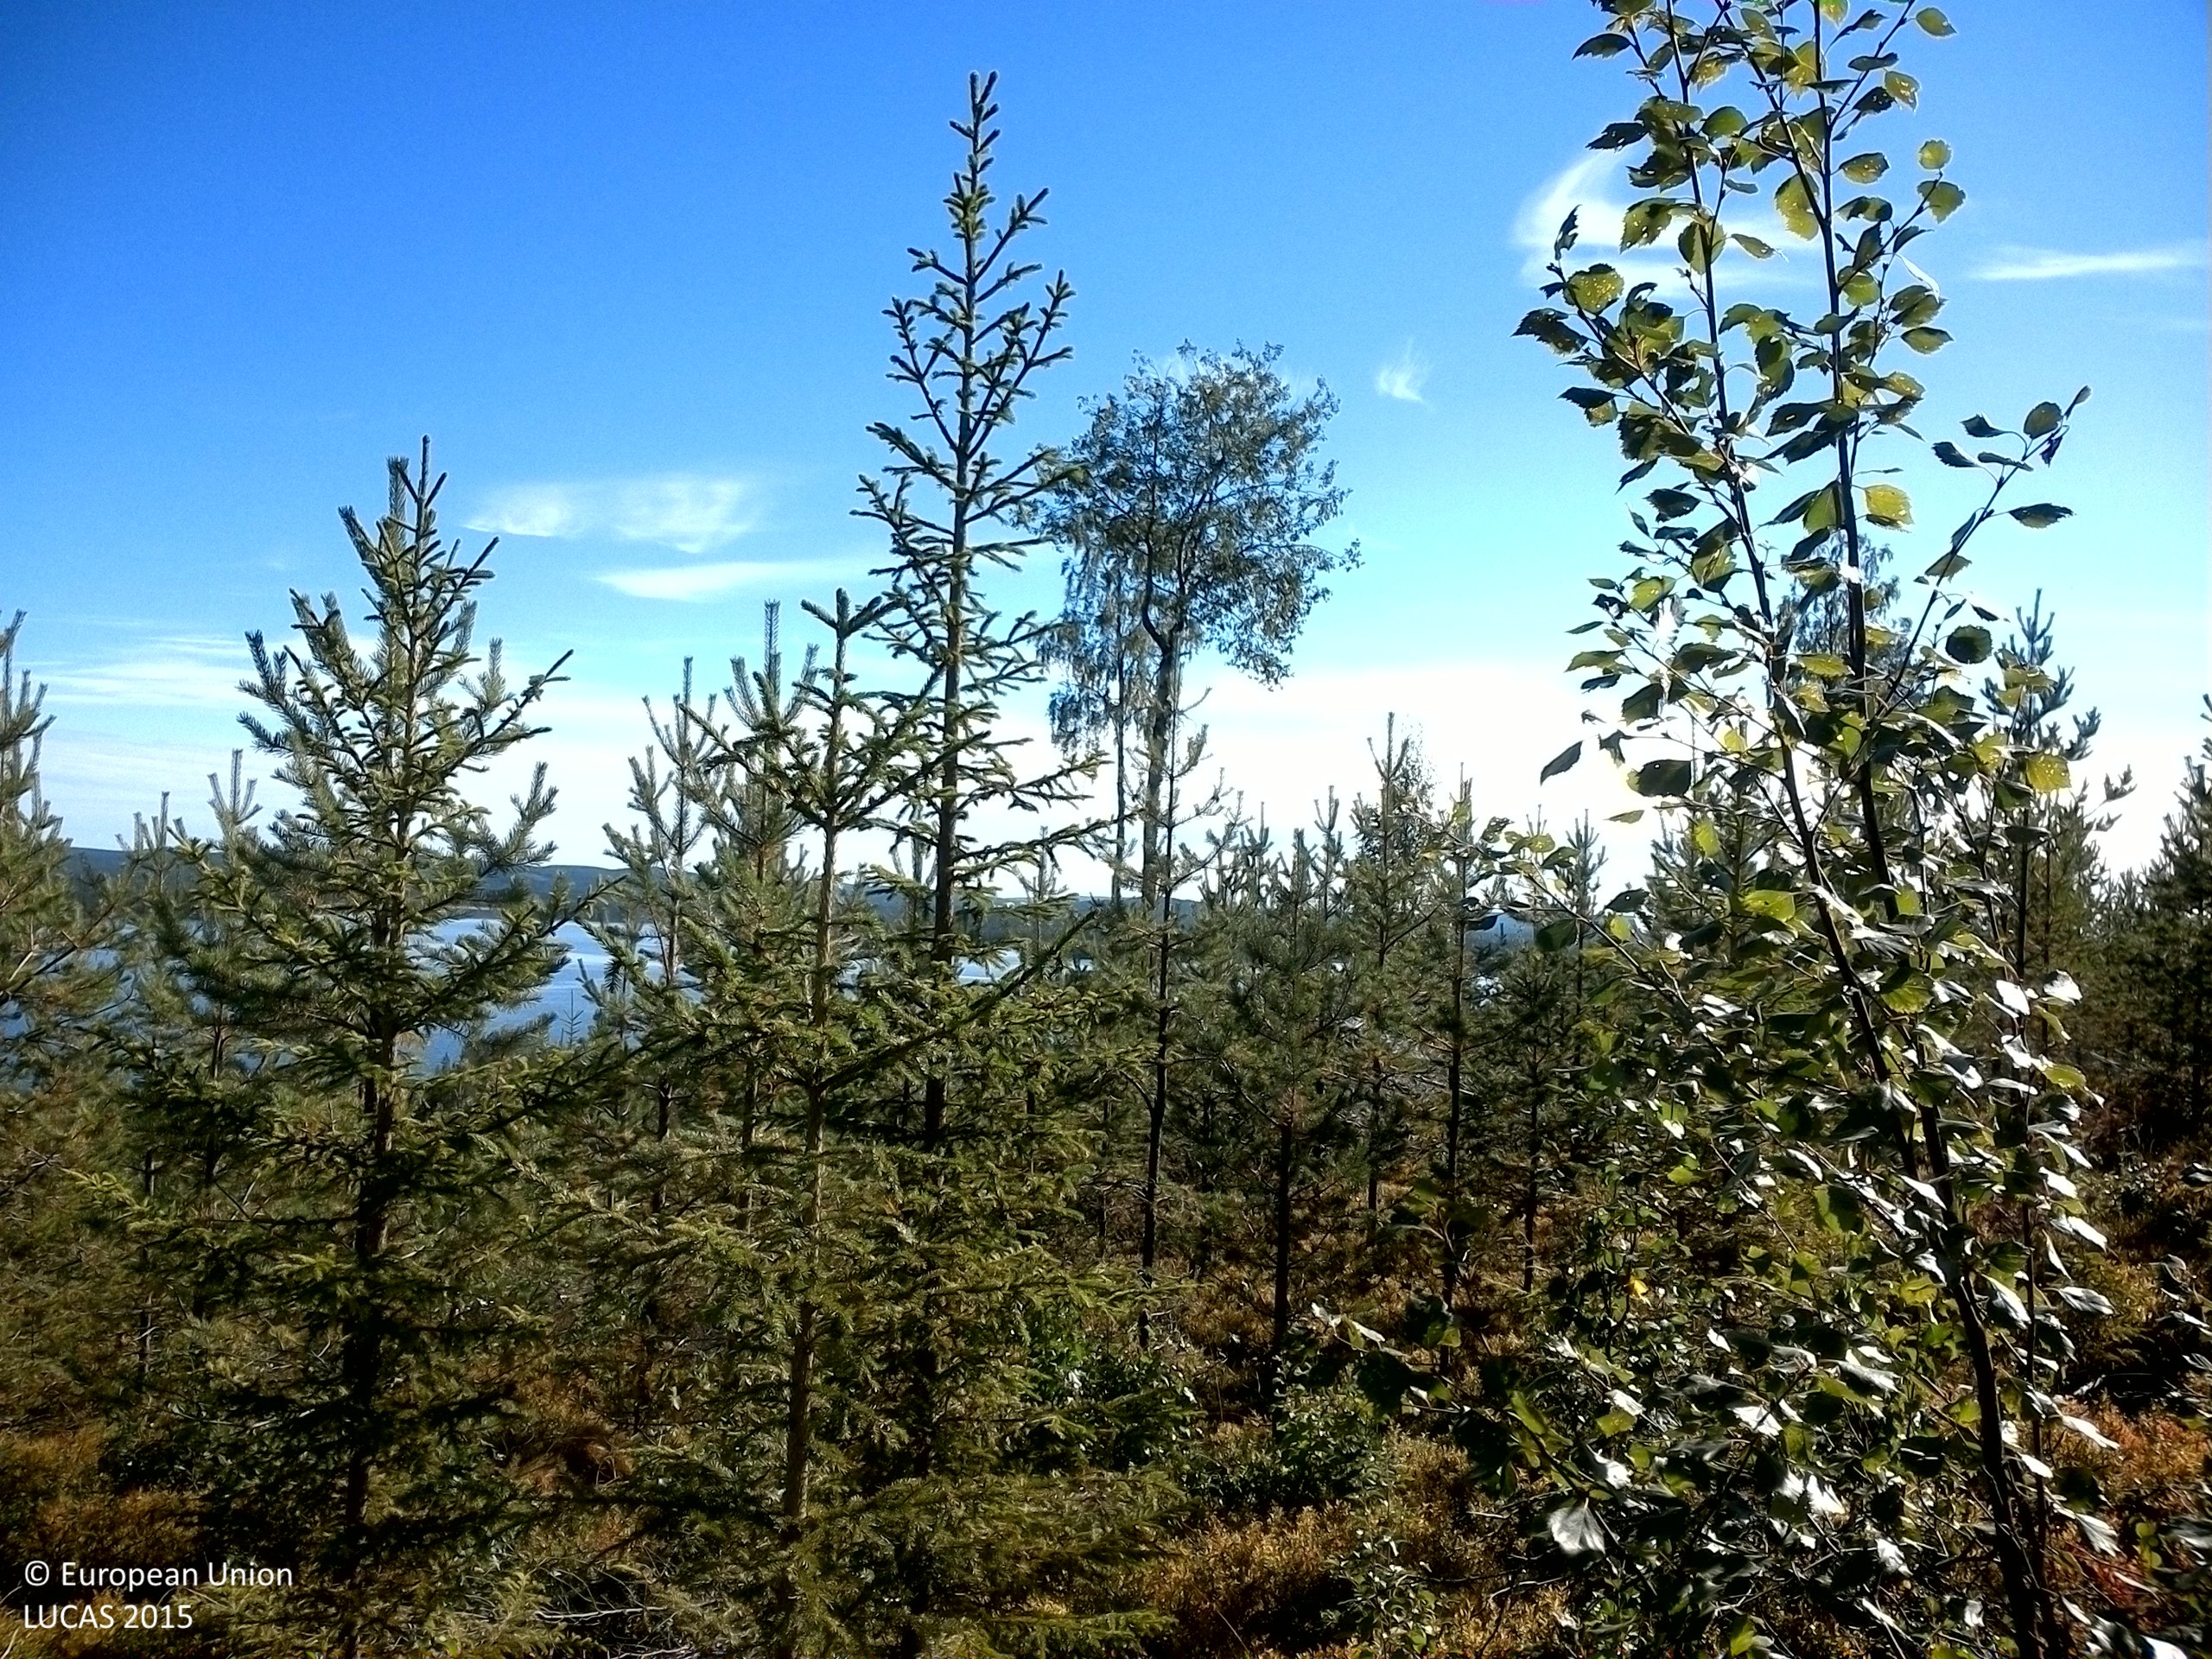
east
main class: Woodland
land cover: Pine dominated mixed woodland
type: boreal forest
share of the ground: 50 - 75 %
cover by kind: coniferous forest trees 40 %, shrubs 25 %, broadleaved forest trees 20 %, lichens and mosses 10 %, herbaceous plants 5 %
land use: Forestry
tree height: < 5 m
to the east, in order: Pine dominated mixed woodland; Pine dominated coniferous woodland; Spruce dominated mixed woodland; Pine dominated mixed woodland; Ditches and canals; Paved roads, cycling and walking lanes; Broadleaved woodland; Pine dominated mixed woodland; Broadleaved woodland; Ditches and canals; Broadleaved woodland
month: August
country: SE
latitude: 63.9277
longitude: 17.1698
